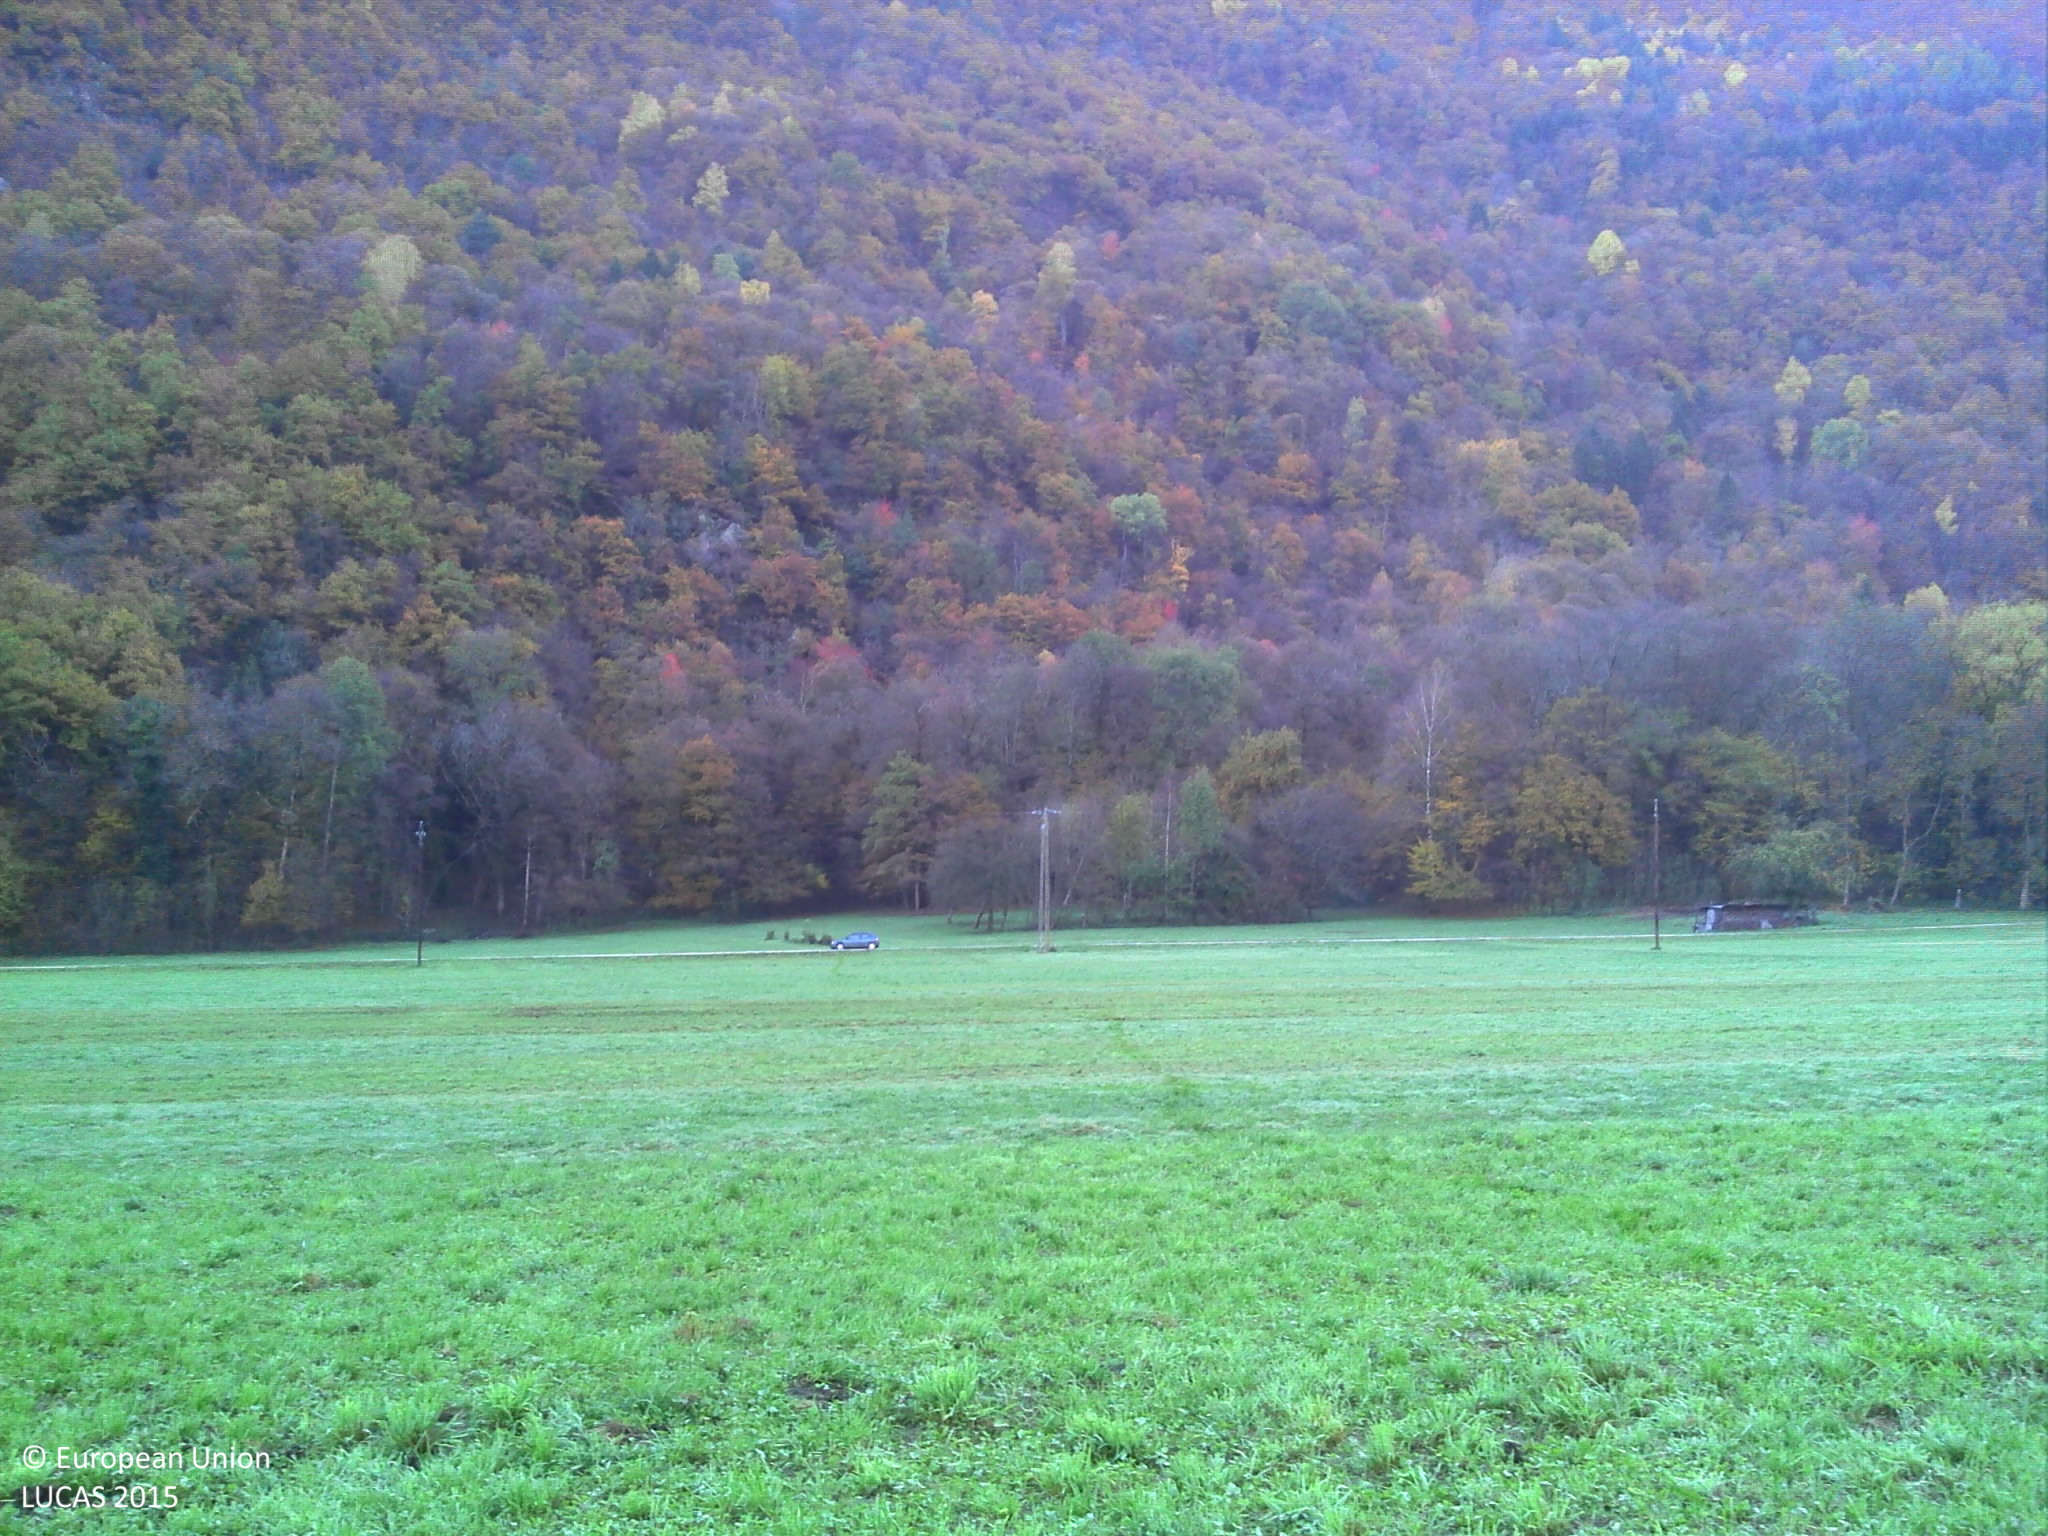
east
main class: Grassland
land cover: Grassland without tree/shrub cover
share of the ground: > 75 %
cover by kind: herbaceous plants 100 %
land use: Agriculture (excluding fallow land and kitchen gardens)
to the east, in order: Grassland without tree/shrub cover; Electric lines; Grass margins; Paved roads, cycling and walking lanes; Grassland with sparse tree/shrub cover; Grassland without tree/shrub cover; Tracks; Broadleaved woodland; Tracks; Broadleaved woodland
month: October
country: FR
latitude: 45.6072
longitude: 6.4527
